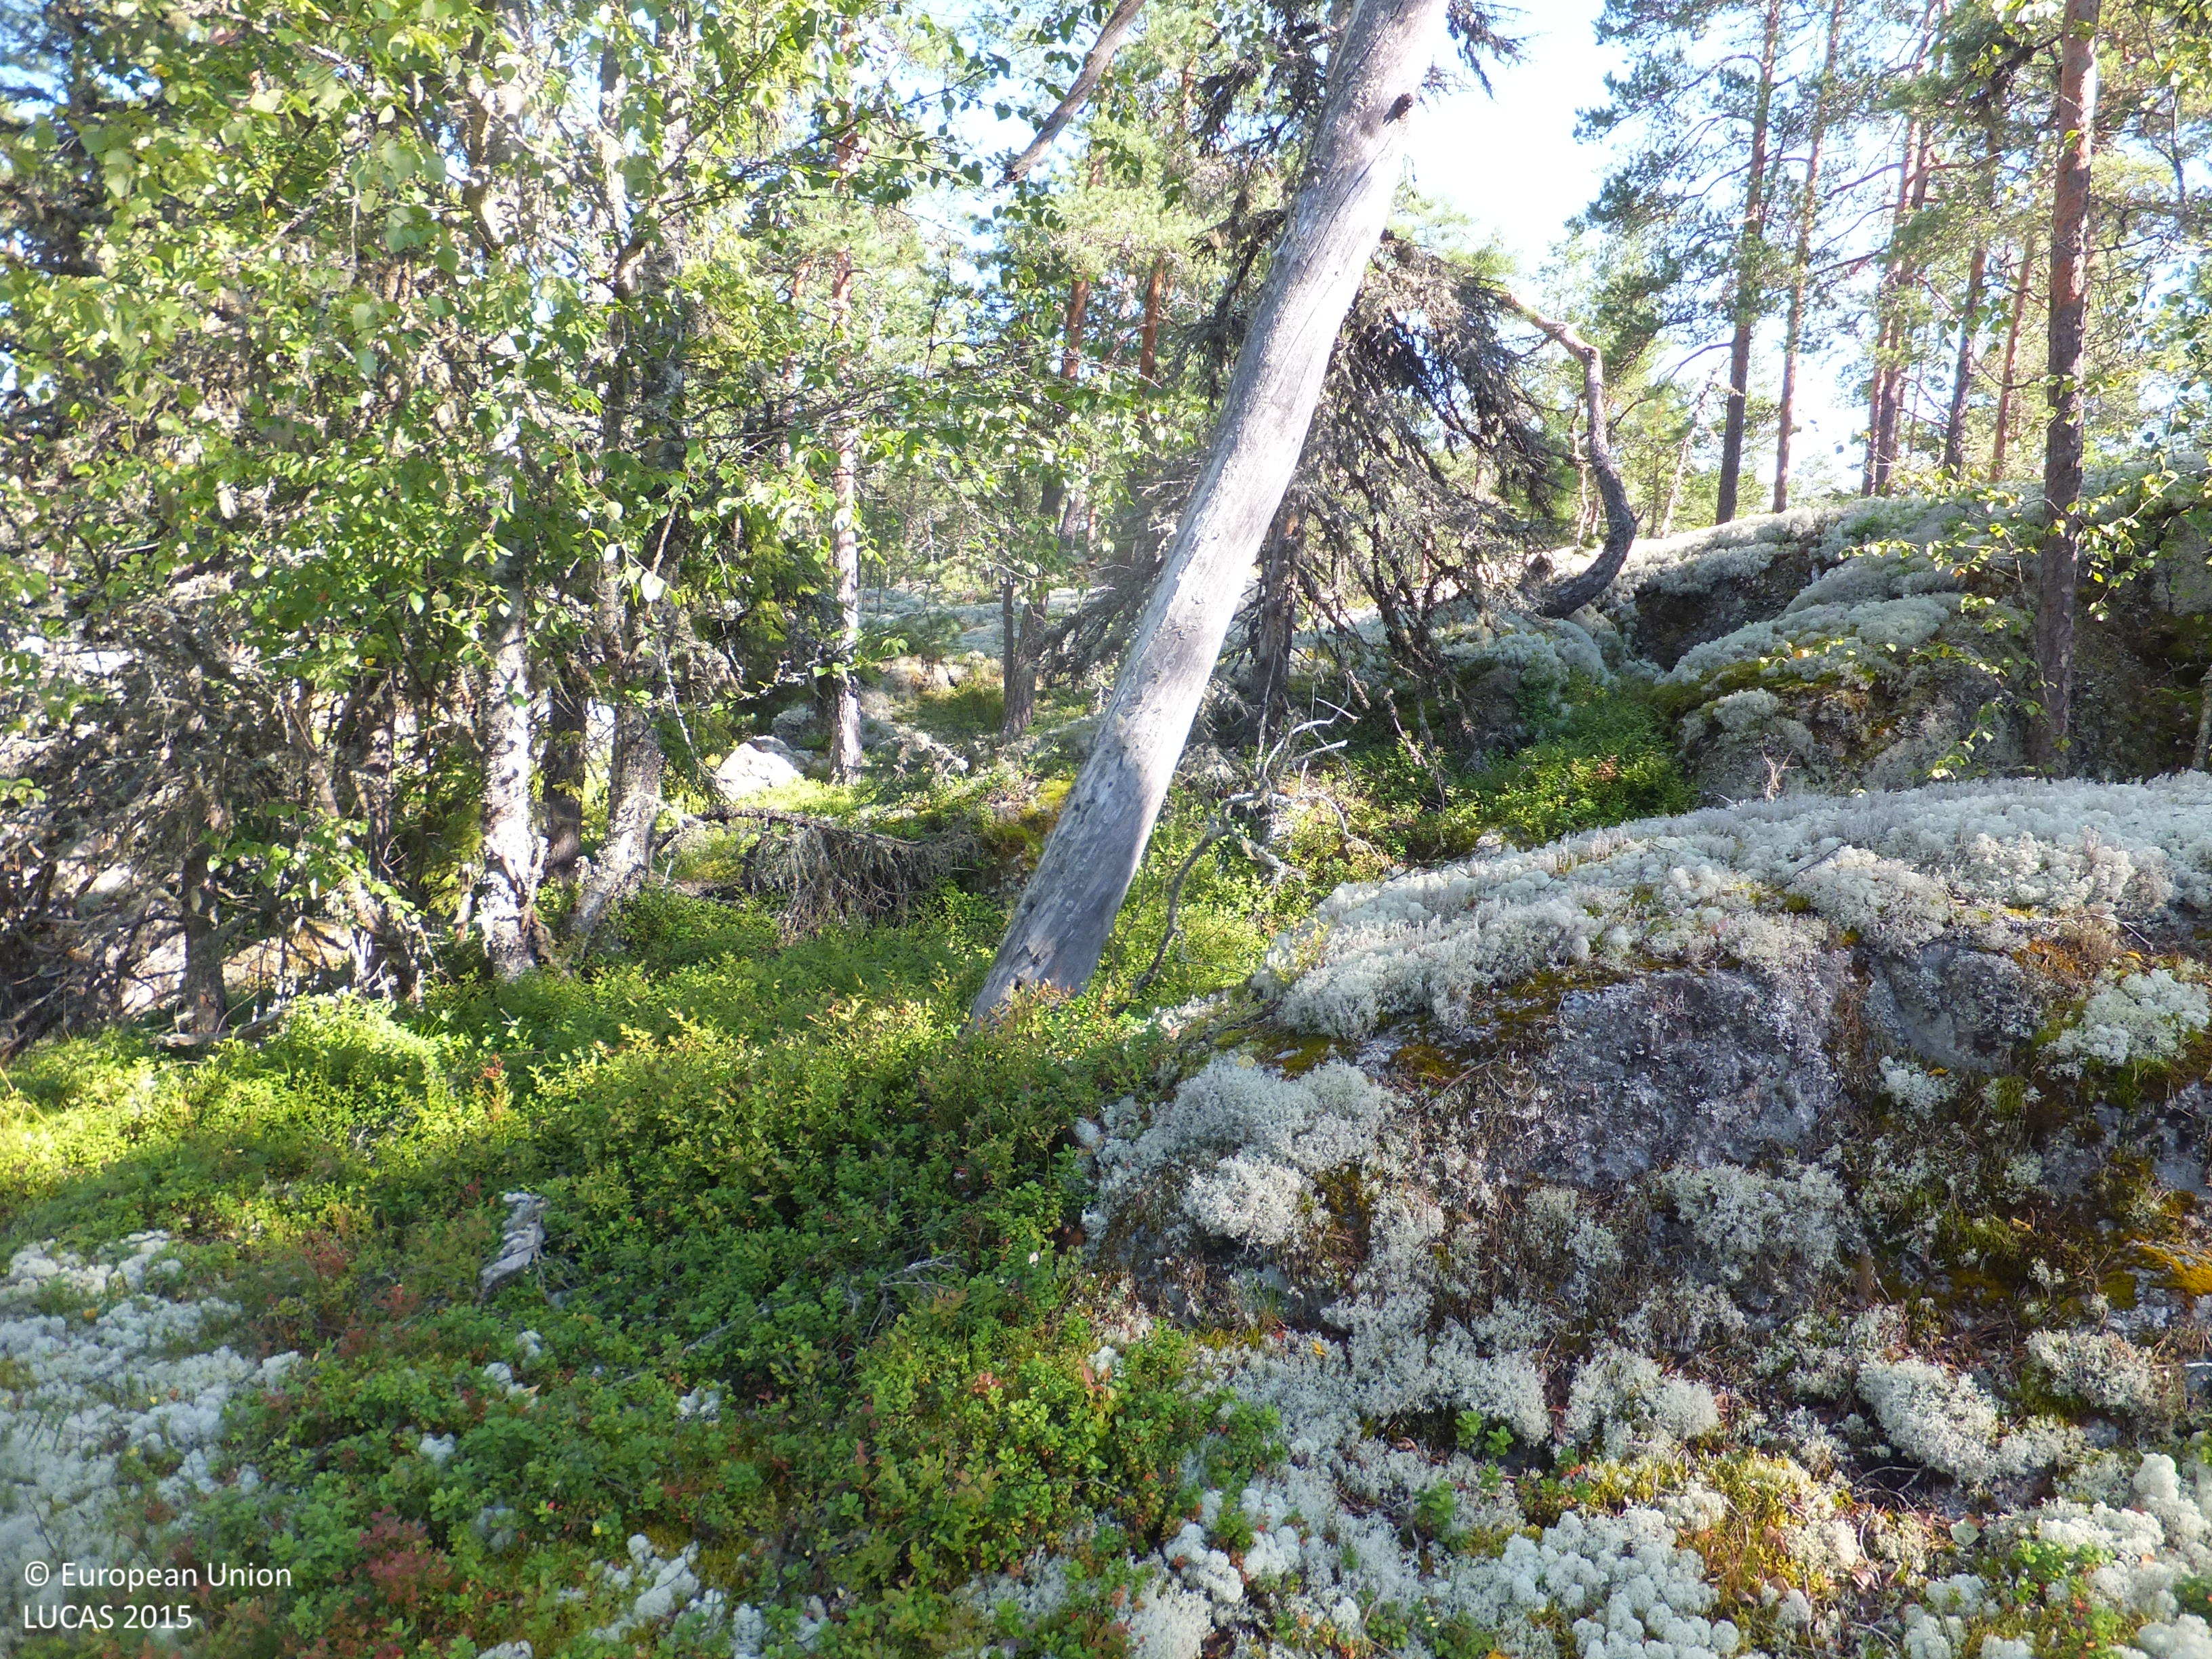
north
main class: Woodland
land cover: Pine dominated mixed woodland
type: boreal forest
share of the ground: 25 - 50 %
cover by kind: lichens and mosses 30 %, shrubs 25 %, coniferous forest trees 20 %, broadleaved forest trees 10 %, herbaceous plants 10 %, consolidated bare surface 5 %
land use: Forestry
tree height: > 5 m
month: August
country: FI
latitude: 63.1149
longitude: 22.0367
